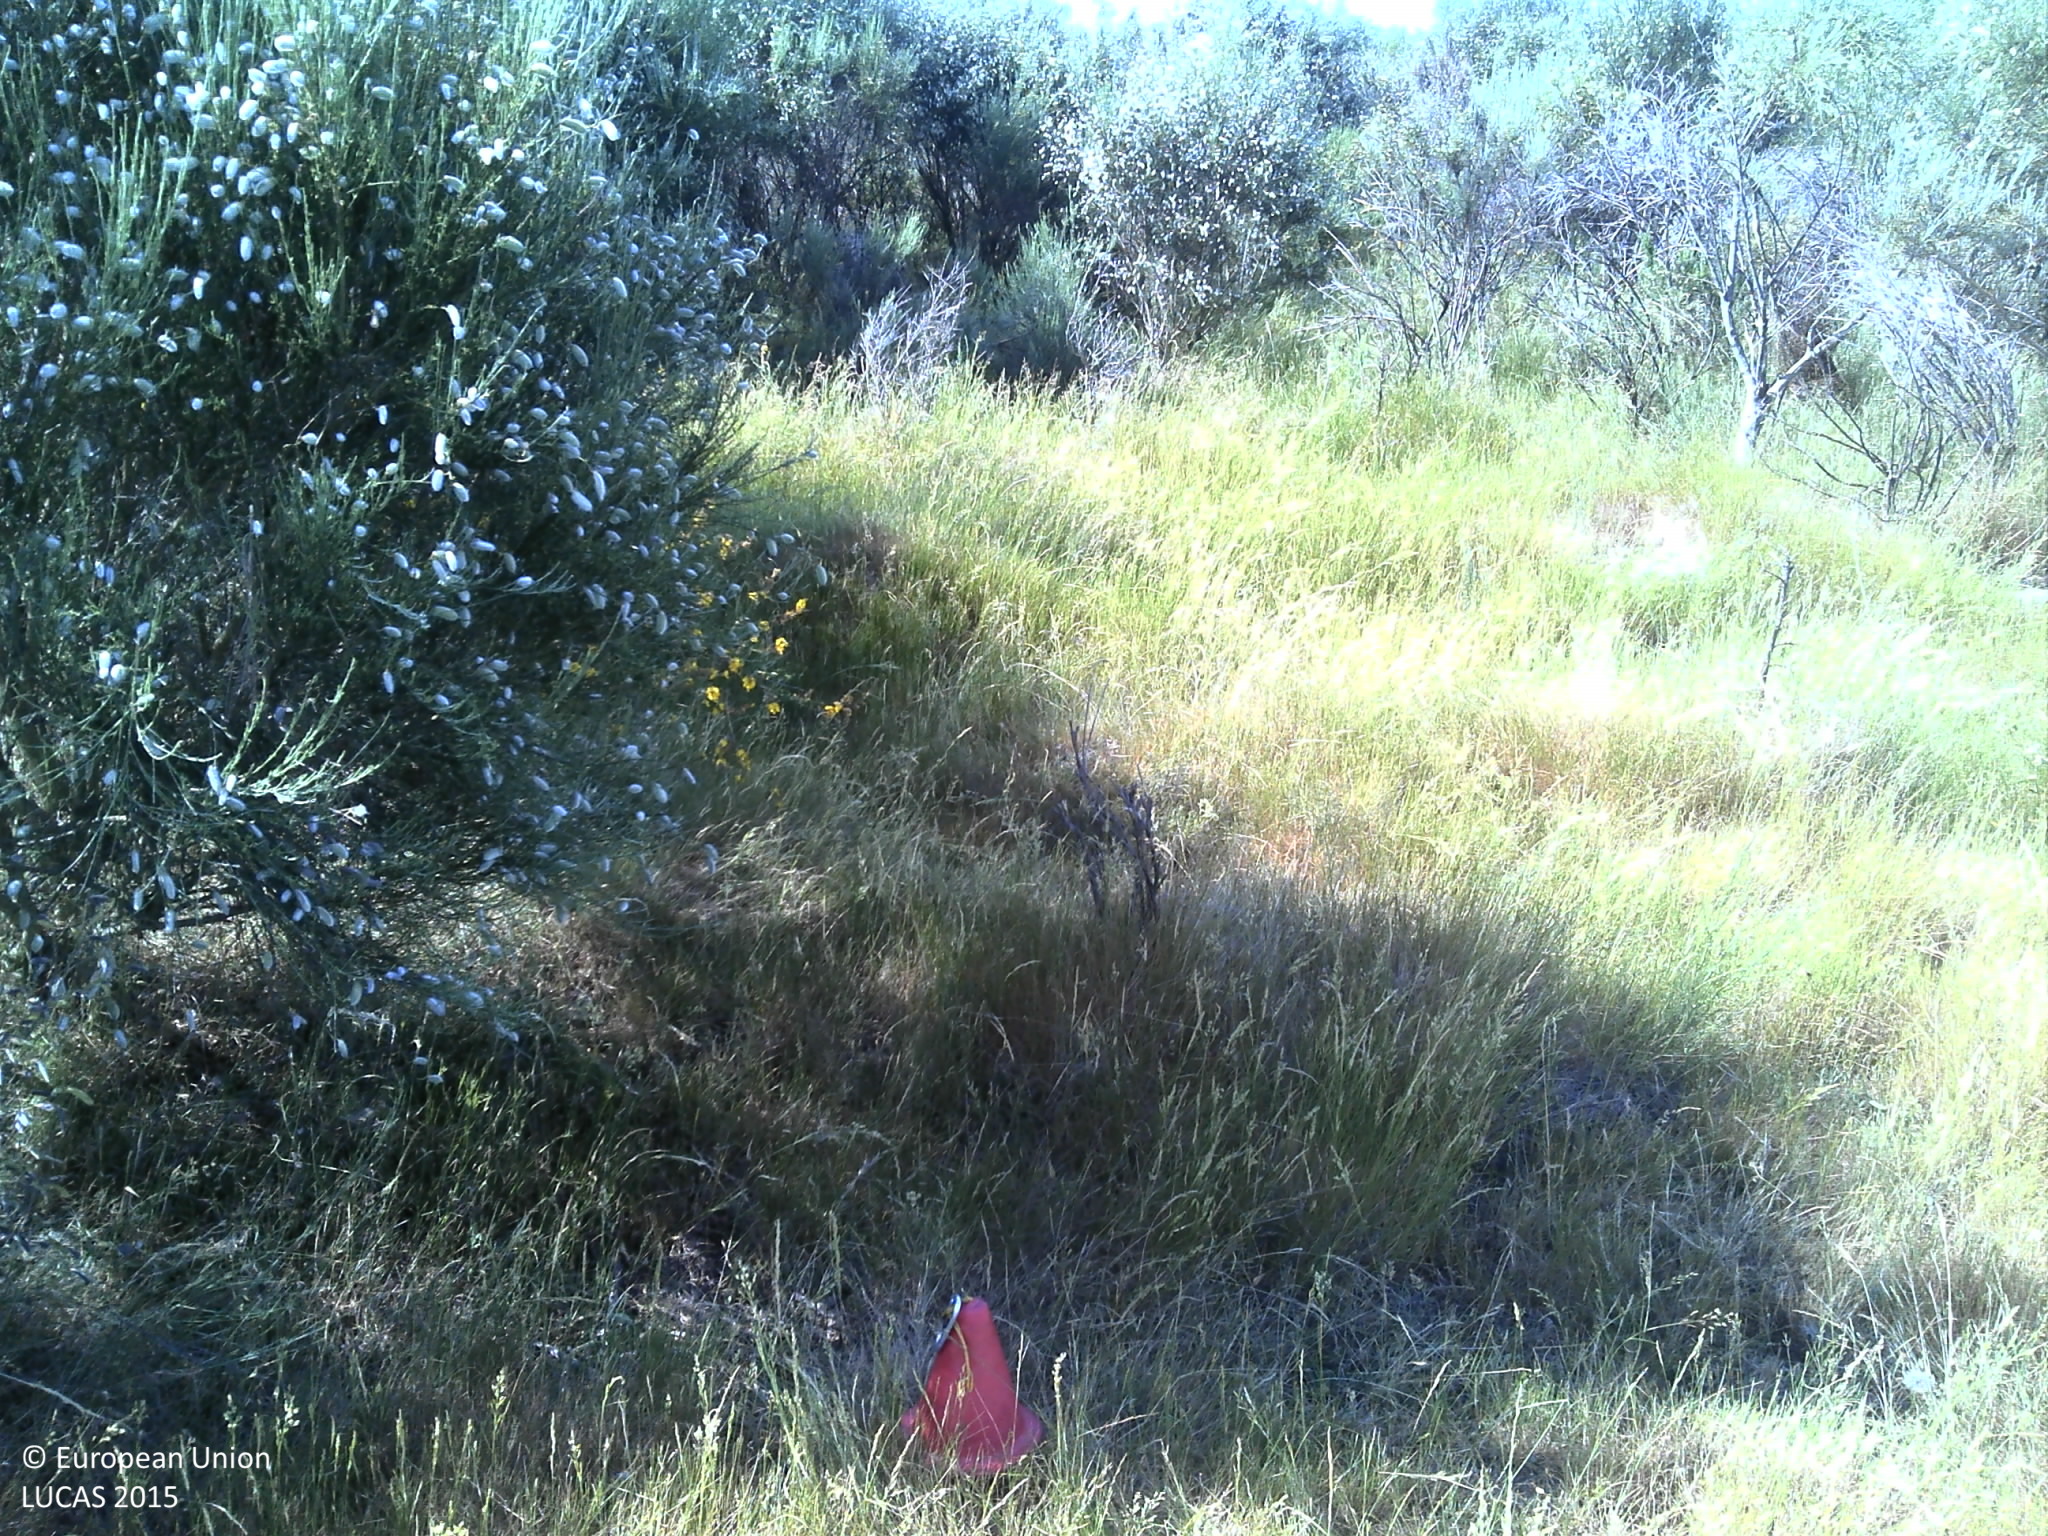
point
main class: Grassland
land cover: Grassland without tree/shrub cover
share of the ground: > 75 %
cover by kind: herbaceous plants 90 %, consolidated bare surface 5 %, unconsolidated bare surface 5 %
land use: Agriculture (excluding fallow land and kitchen gardens)
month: July
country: PT
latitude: 41.5033
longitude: -7.7076
